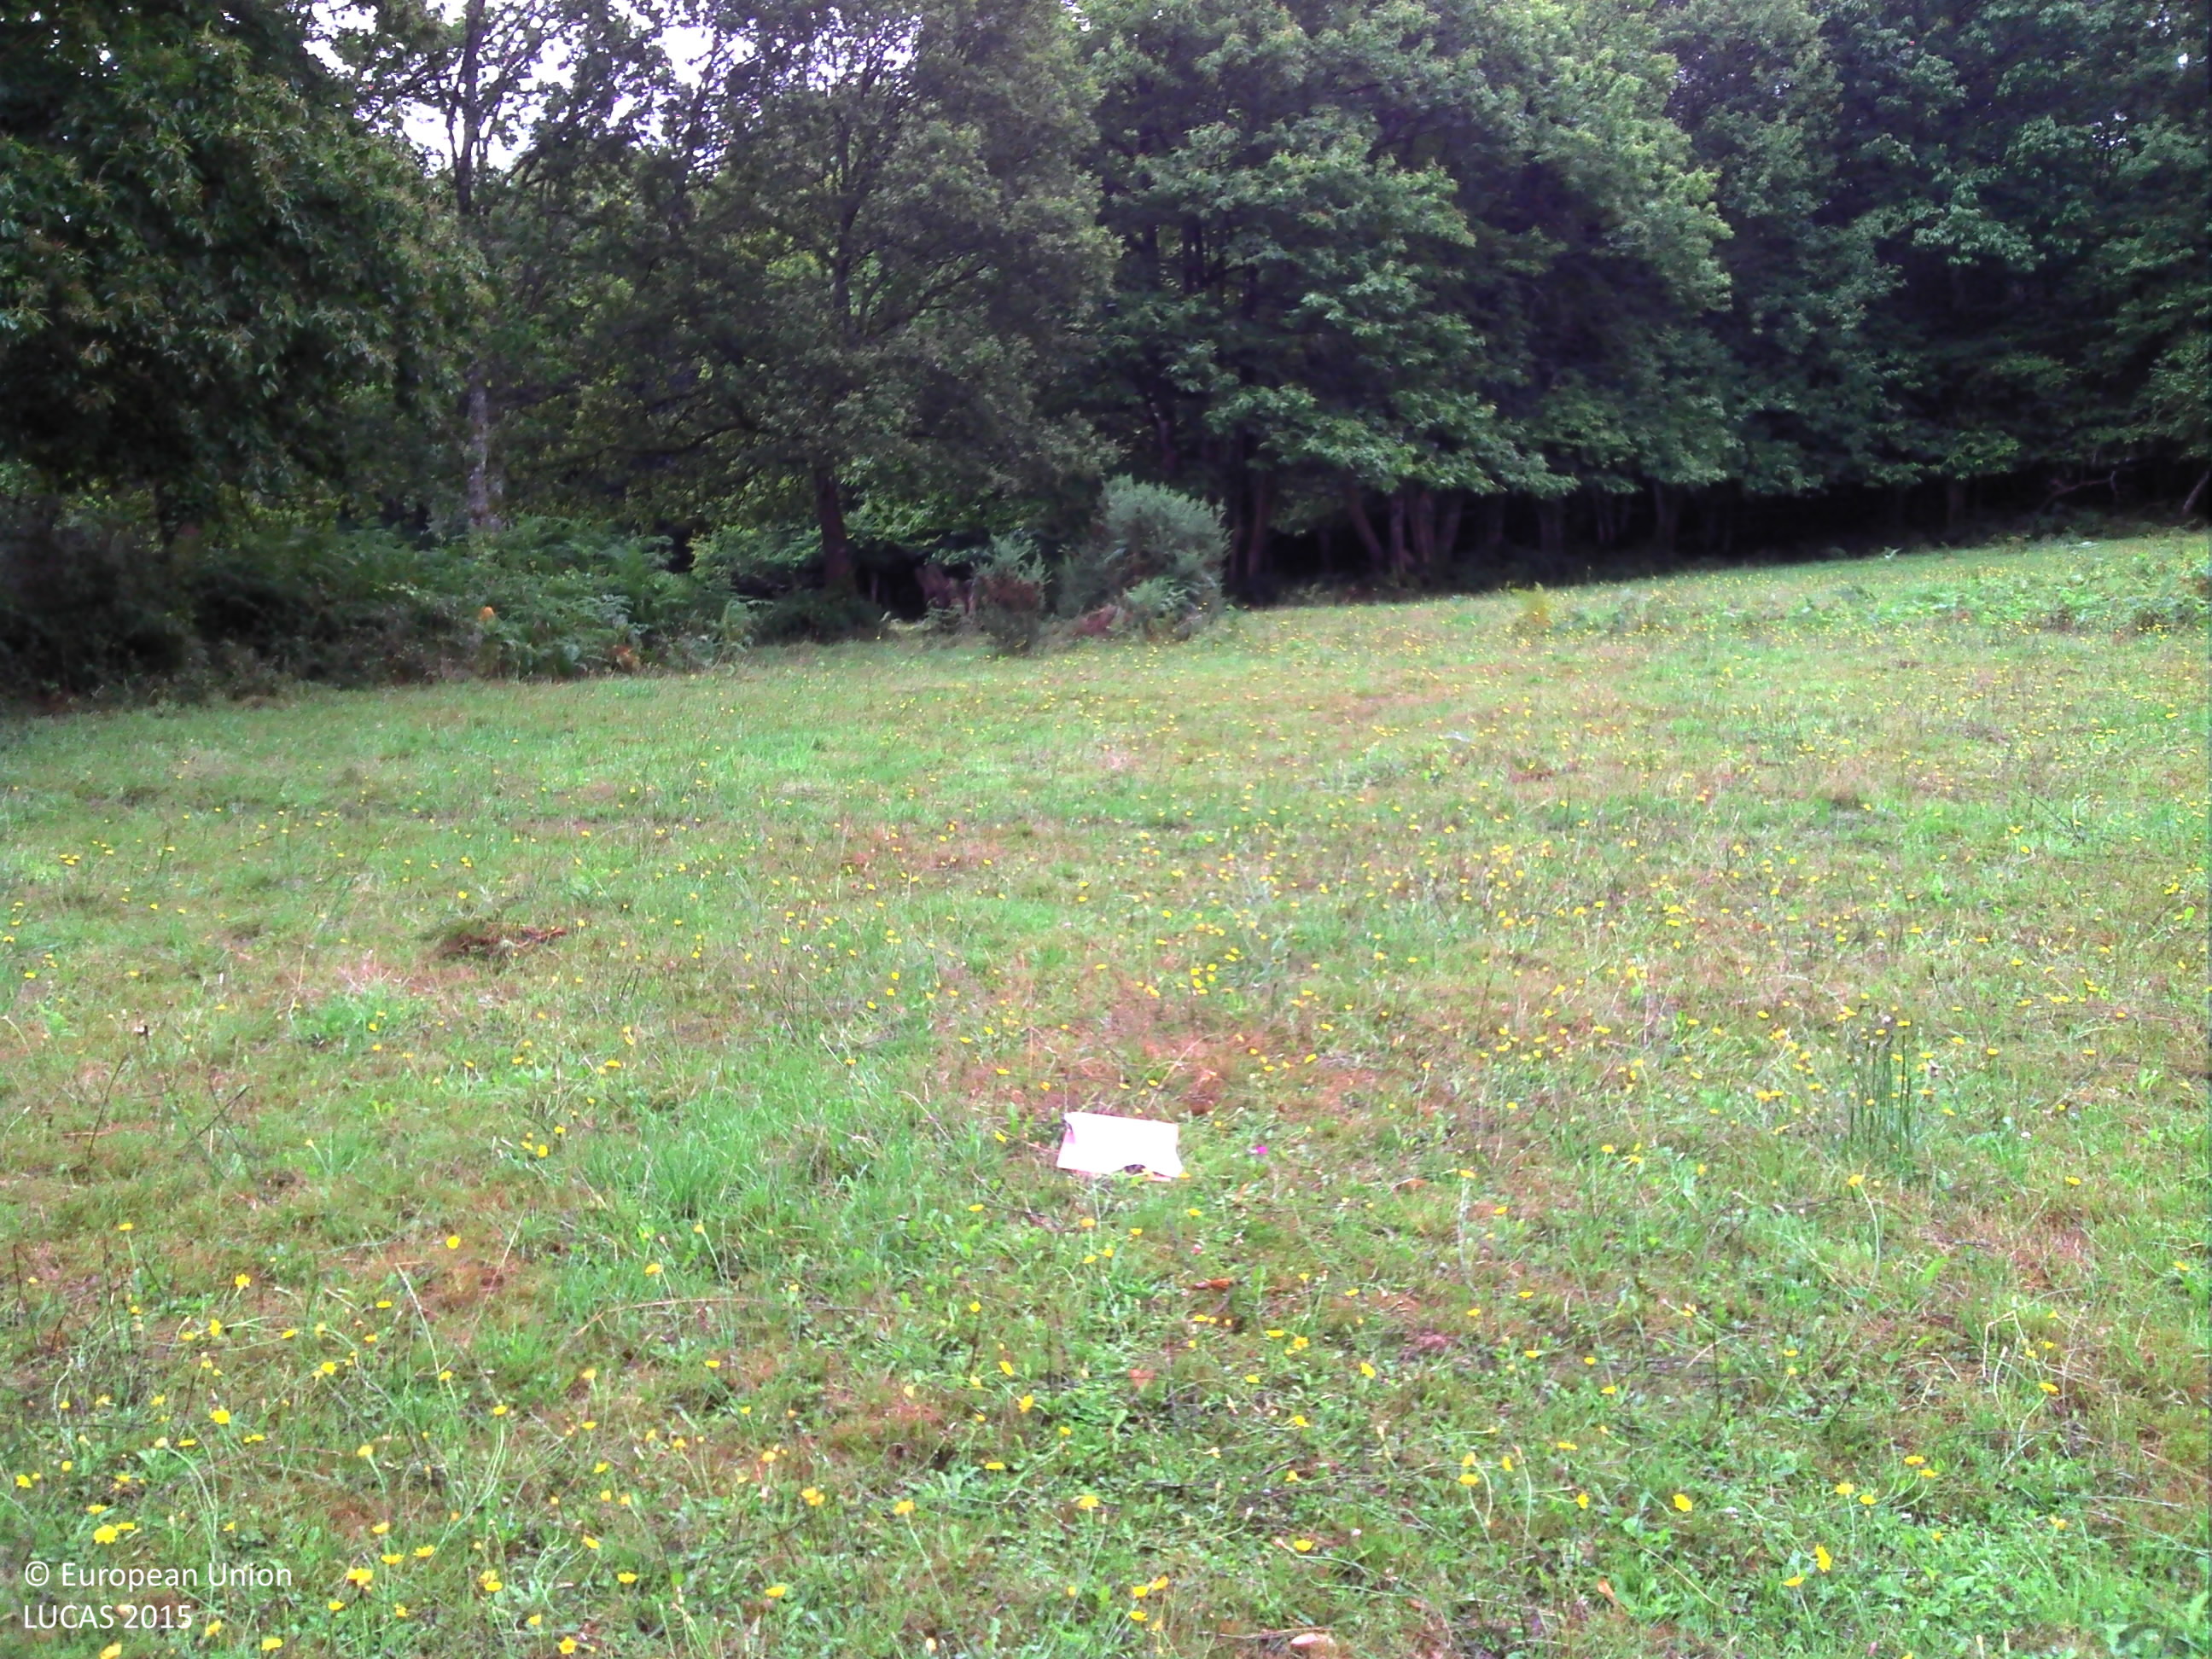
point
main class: Grassland
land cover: Grassland without tree/shrub cover
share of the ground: > 75 %
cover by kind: herbaceous plants 70 %, consolidated bare surface 20 %, shrubs 5 %, unconsolidated bare surface 5 %
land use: Agriculture (excluding fallow land and kitchen gardens)
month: July
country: FR
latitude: 48.0237
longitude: -3.5262
